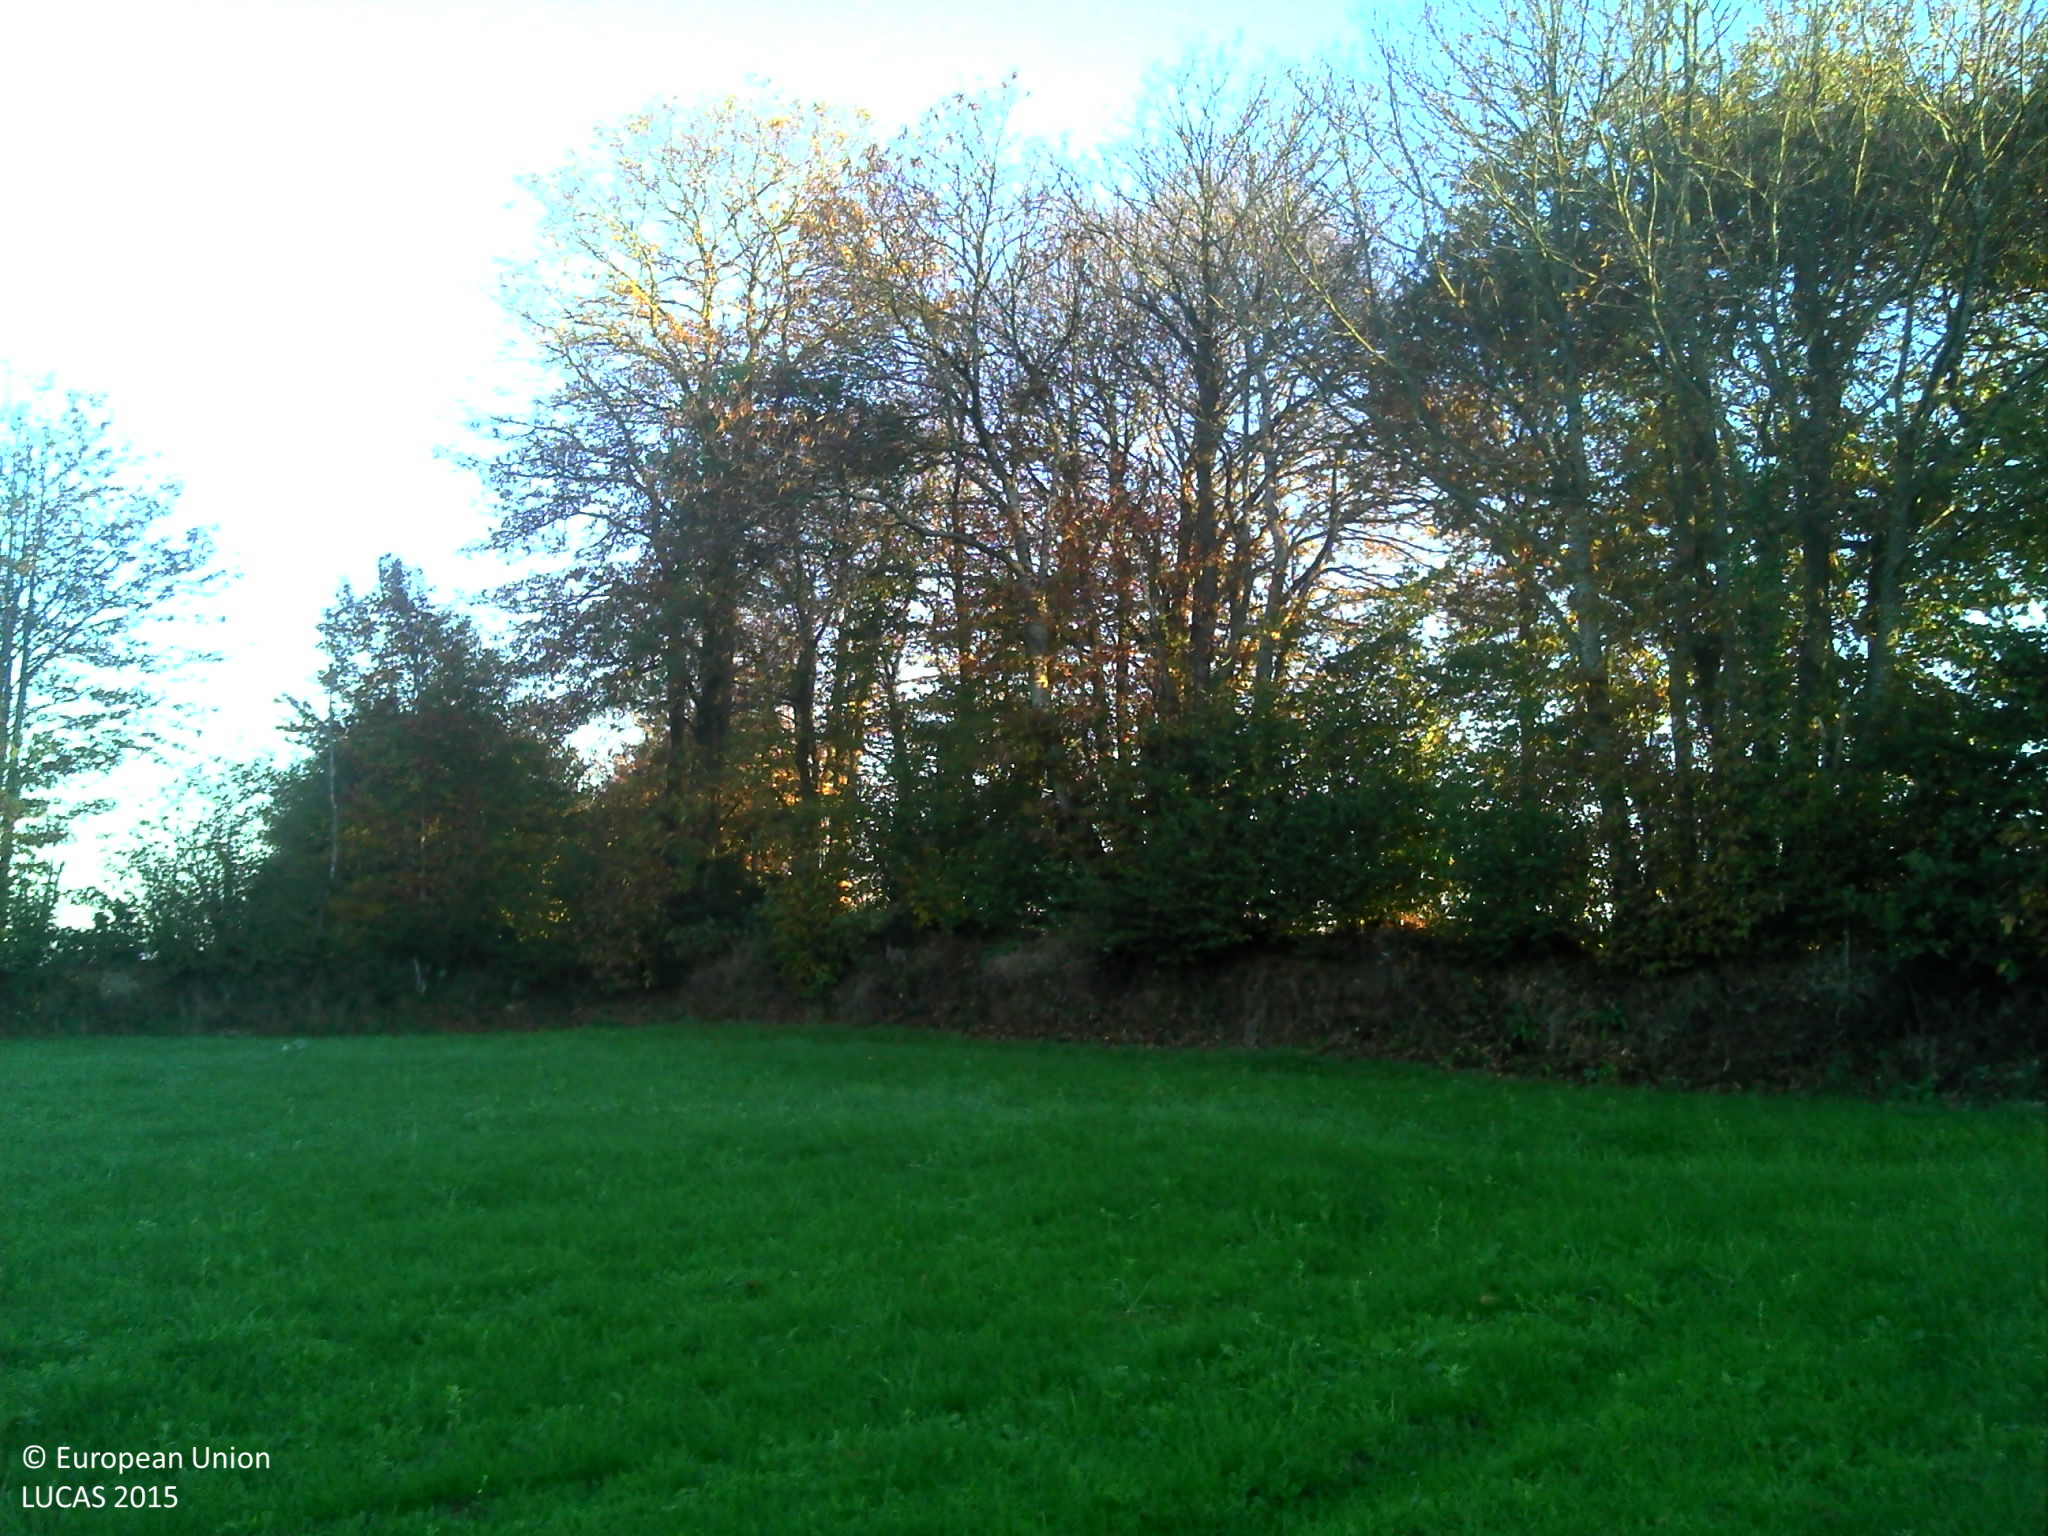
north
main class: Cropland
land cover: Temporary grasslands
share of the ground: > 75 %
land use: Agriculture (excluding fallow land and kitchen gardens)
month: November
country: FR
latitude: 48.1053
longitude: -3.6030
